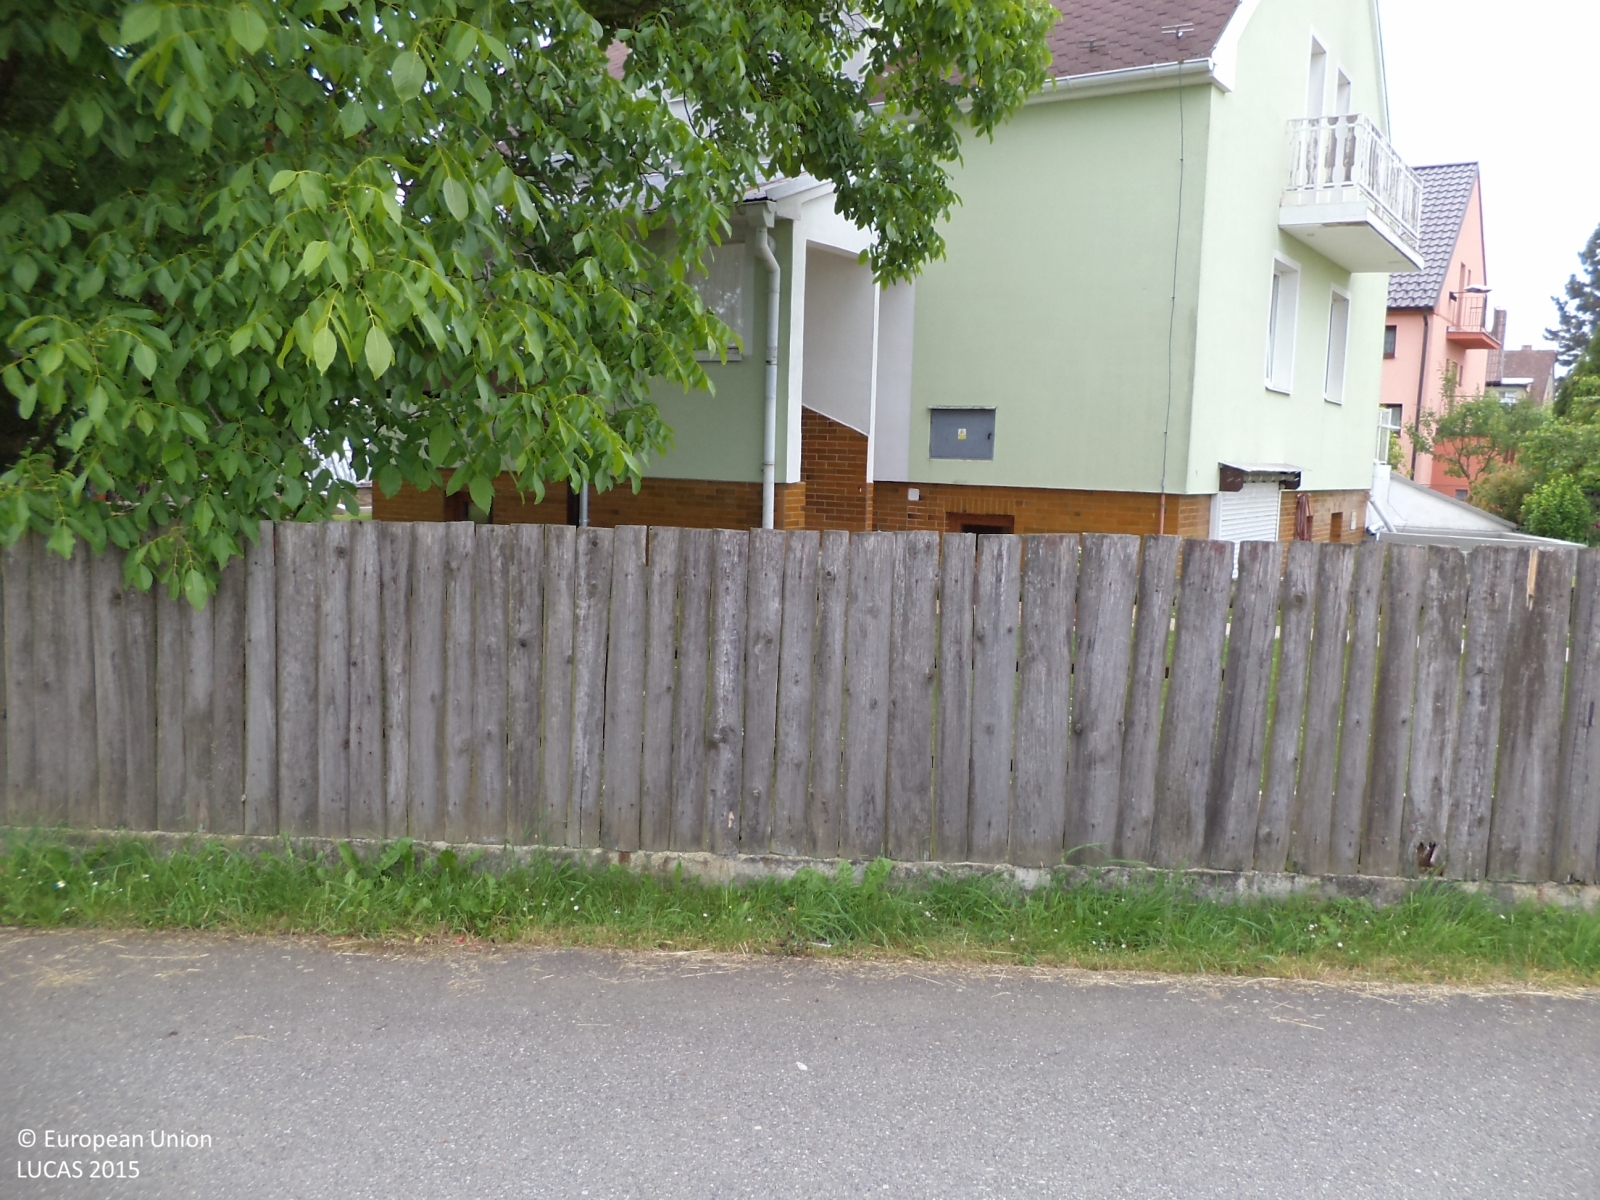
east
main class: Cropland
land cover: Rape and turnip rape
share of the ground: > 75 %
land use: Agriculture (excluding fallow land and kitchen gardens)
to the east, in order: Rape and turnip rape; Grass margins; Artificial constructions in urban areas
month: June
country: CZ
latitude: 49.1468
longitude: 14.3468
